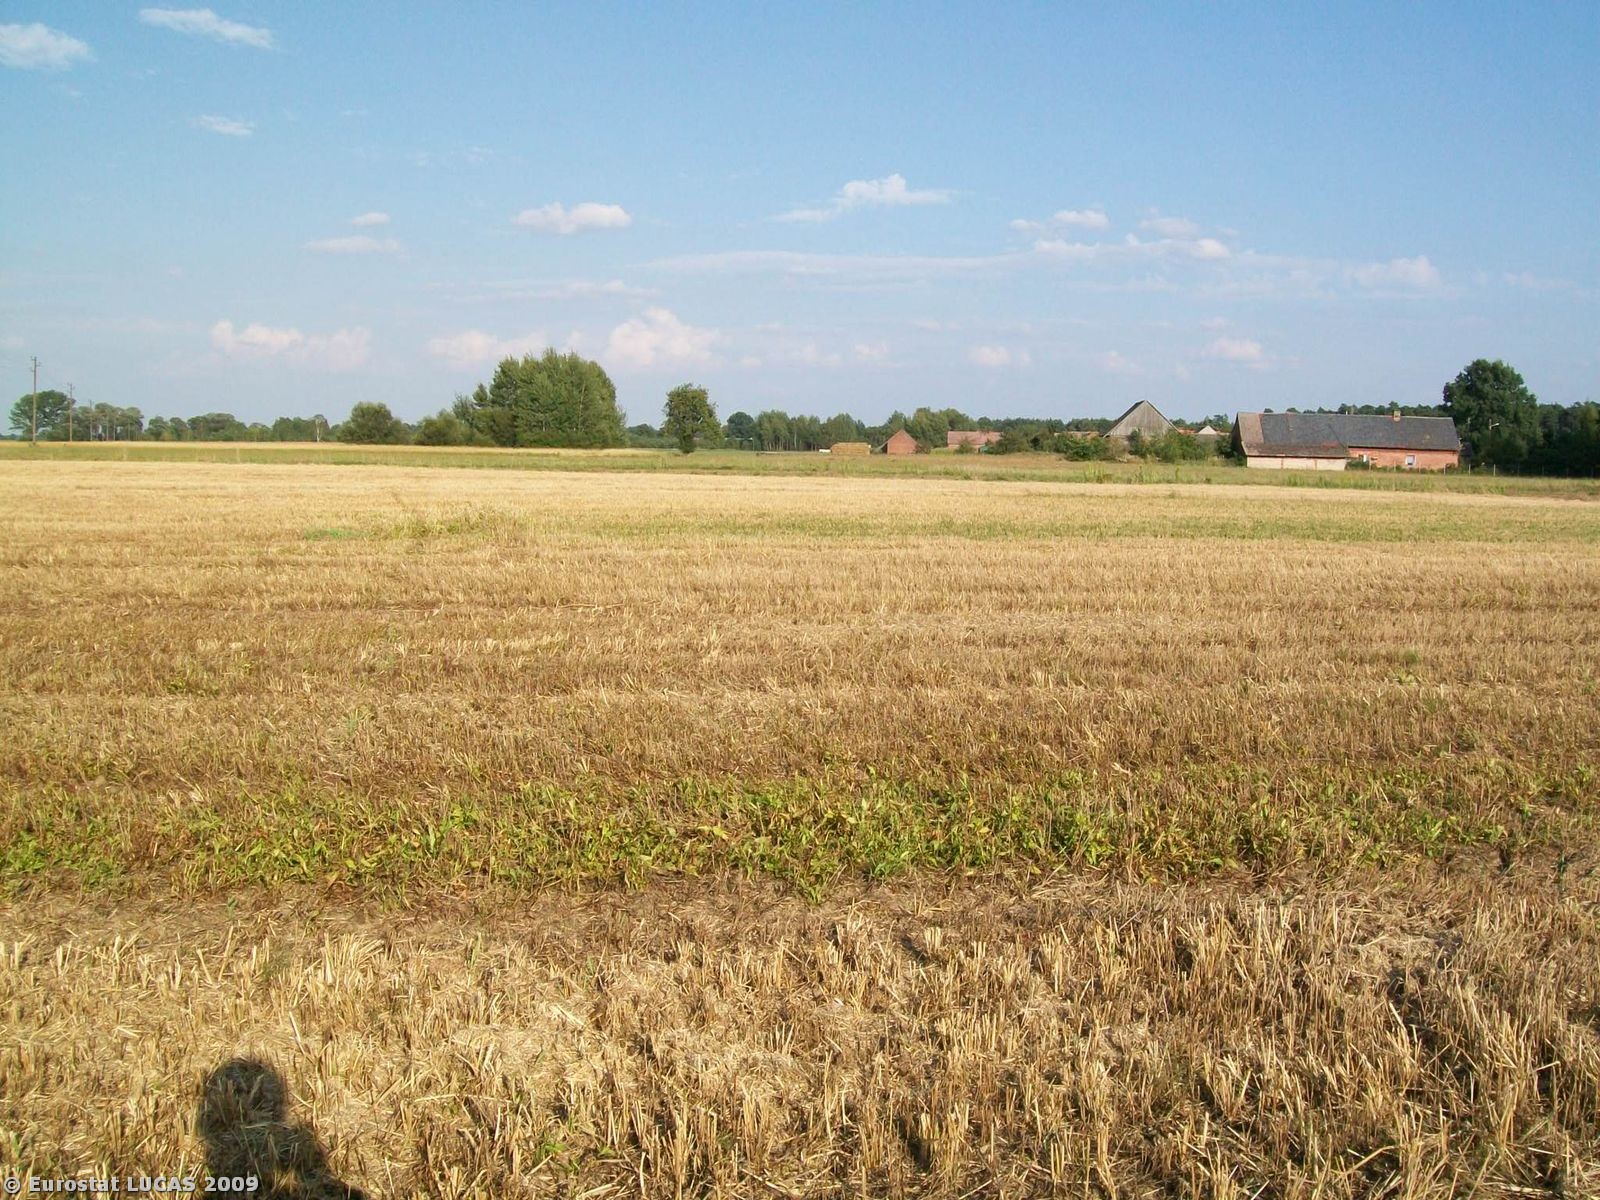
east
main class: Cropland
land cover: Barley
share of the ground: < 10 %
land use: Agriculture (excluding fallow land and kitchen gardens)
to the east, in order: Barley; Triticale; Barley; Grassland without tree/shrub cover
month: August
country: PL
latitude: 50.9745
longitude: 17.9196
